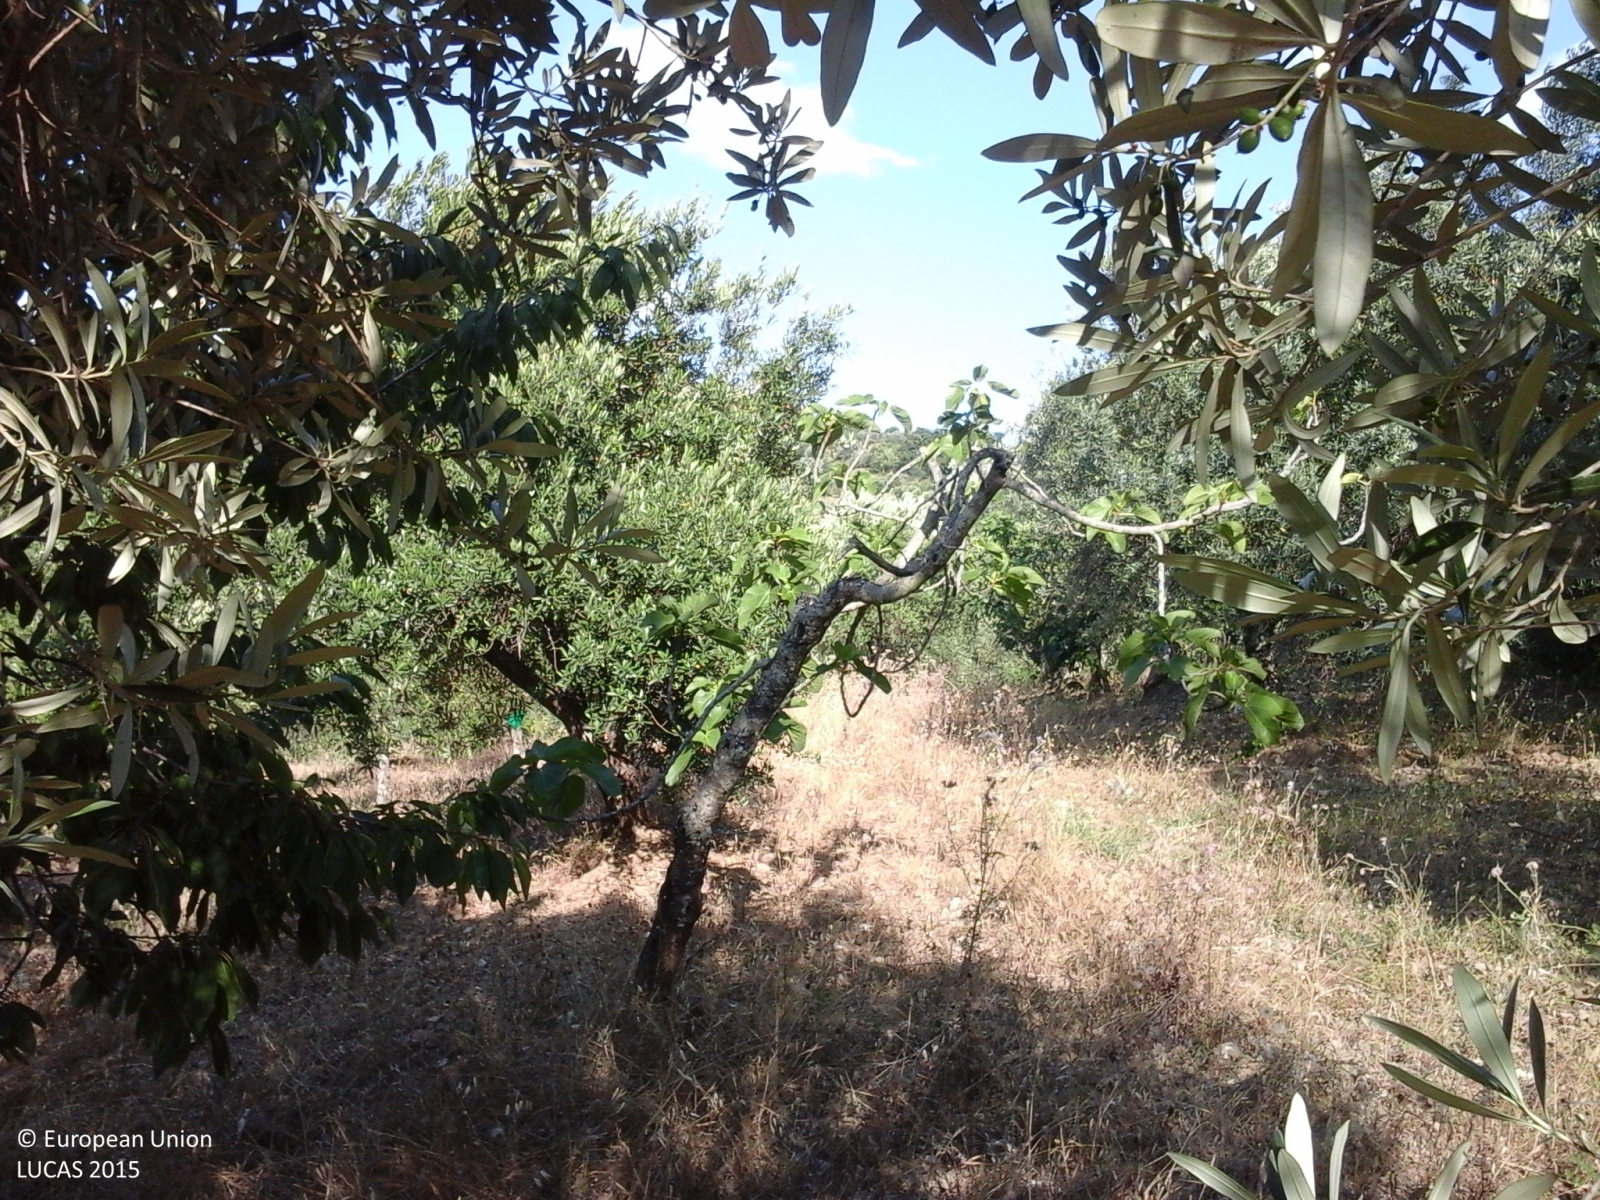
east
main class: Cropland
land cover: Olive groves
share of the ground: 50 - 75 %
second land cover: Other fruit trees and berries
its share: 10 - 25 %
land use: Agriculture (excluding fallow land and kitchen gardens)
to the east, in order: Olive groves; Other fruit trees and berries; Spontaneously vegetated surfaces; Broadleaved woodland; Olive groves; Spontaneously vegetated surfaces; Other fruit trees and berries; Other bare soil; Dry stone walls; Olive groves; Other bare soil; Dry stone walls; Olive groves; Other bare soil; Dry stone walls; Olive groves; Spontaneously vegetated surfaces
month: June
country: IT
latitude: 40.2114
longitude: 15.0180
